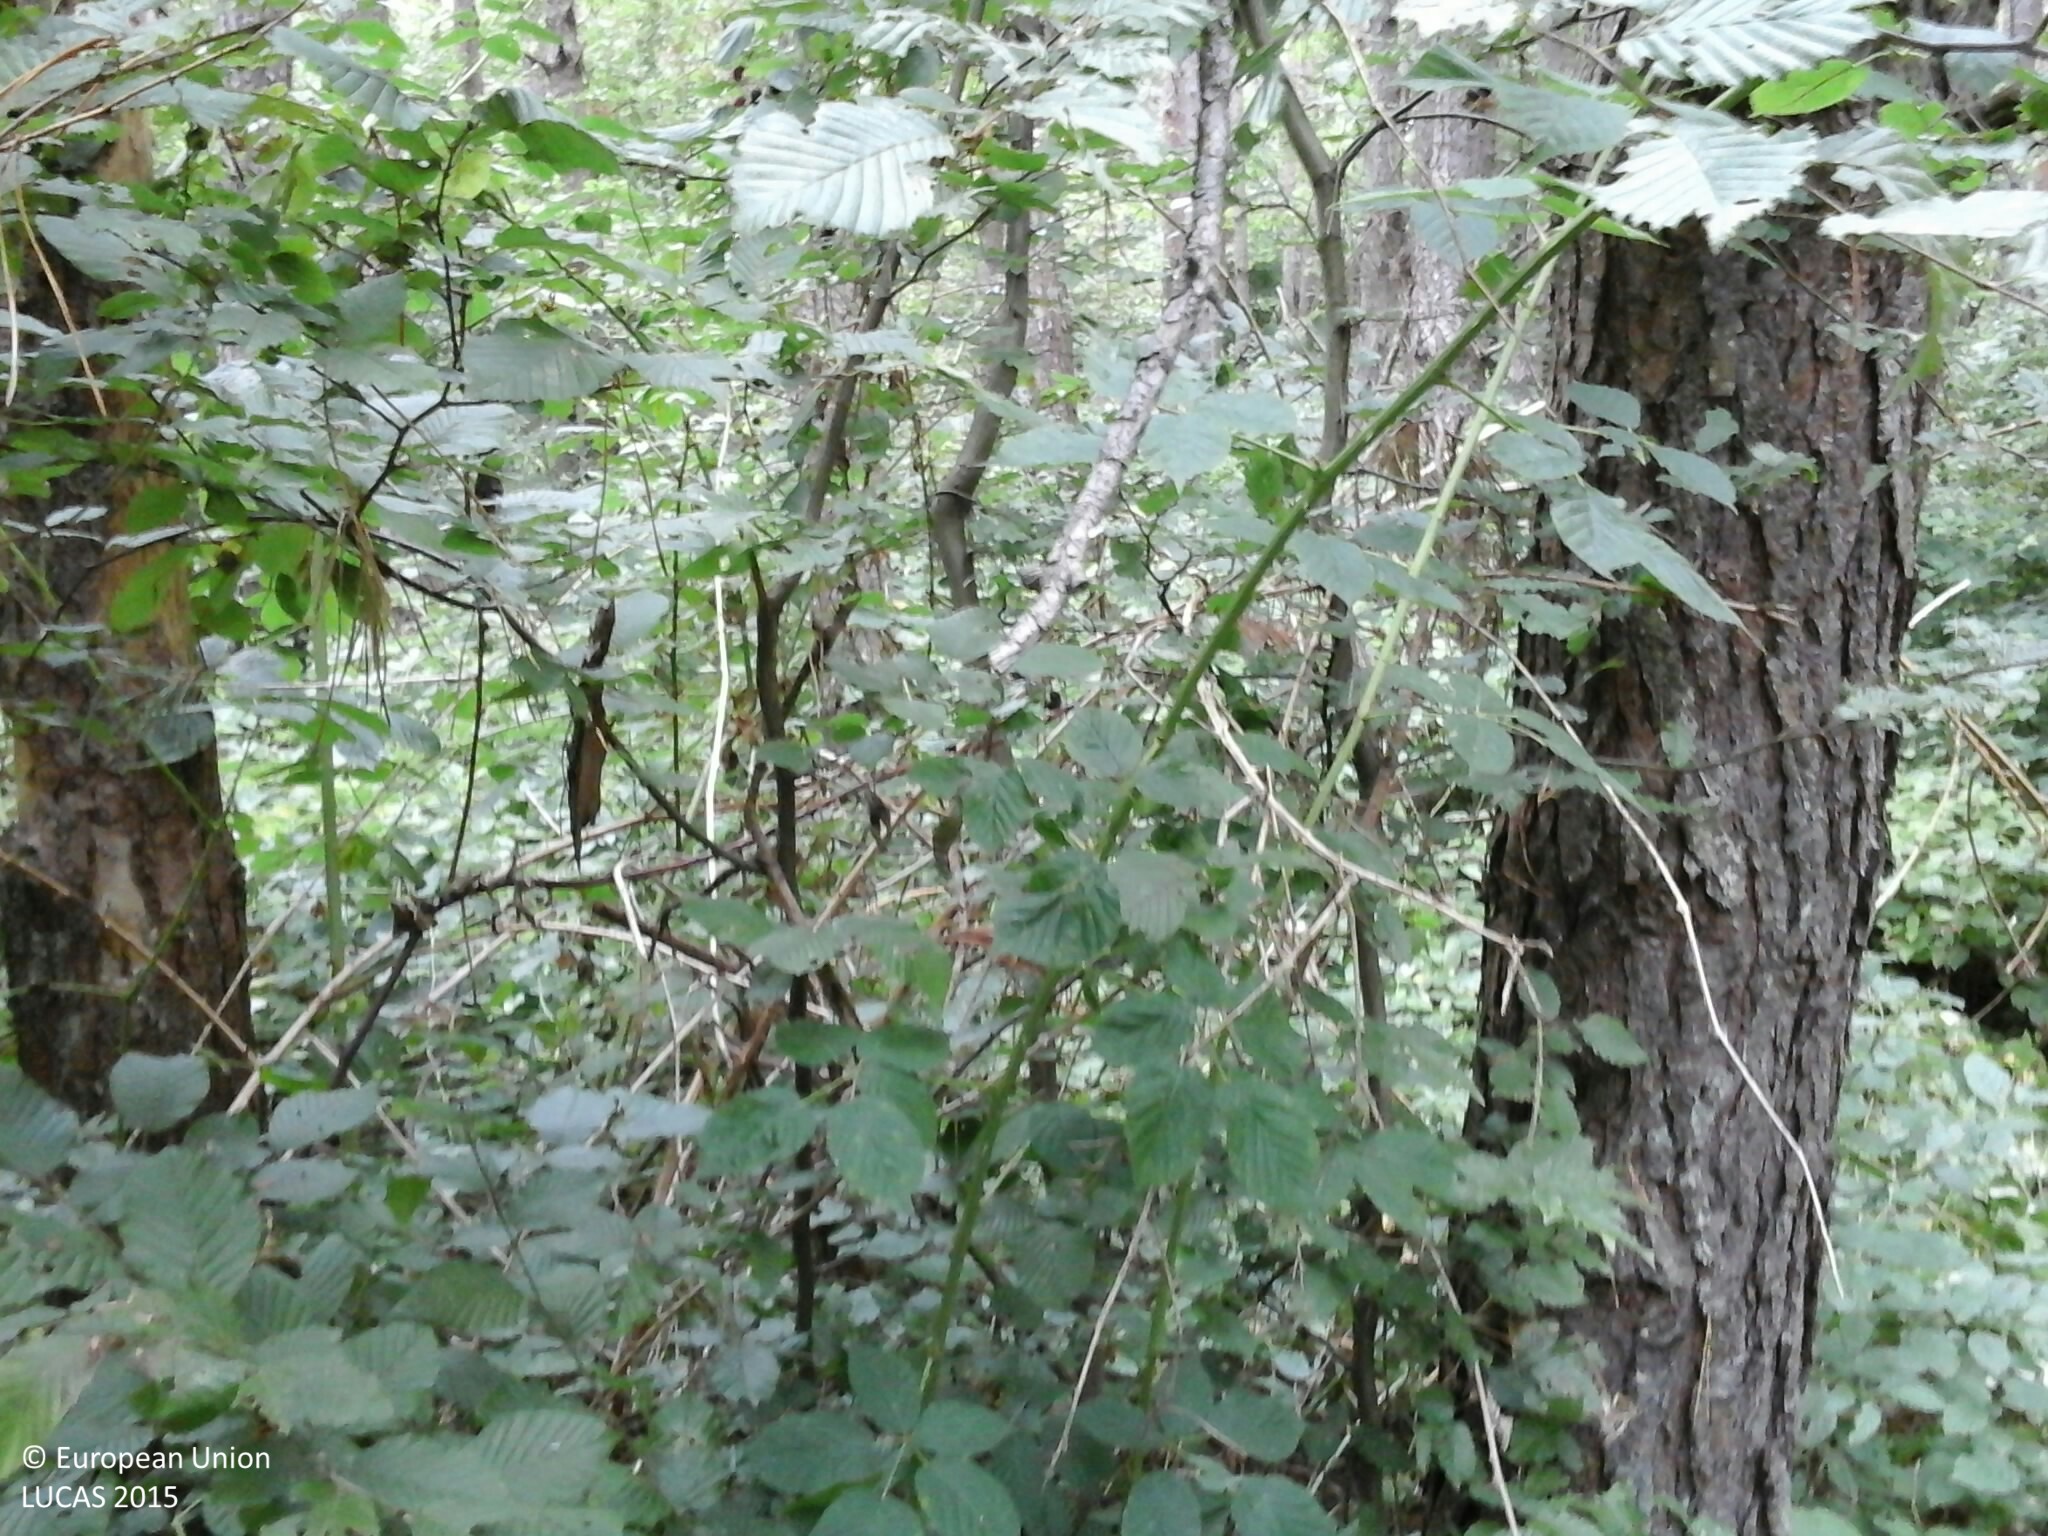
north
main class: Woodland
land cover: Other coniferous woodland
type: hemiboreal forest and nemoral coniferous forest and mixed broadleaved-coniferous forest
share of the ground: > 75 %
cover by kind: coniferous forest trees 60 %, shrubs 30 %, herbaceous plants 10 %
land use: Forestry
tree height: > 5 m
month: July
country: HU
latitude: 46.7476
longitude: 16.5337
